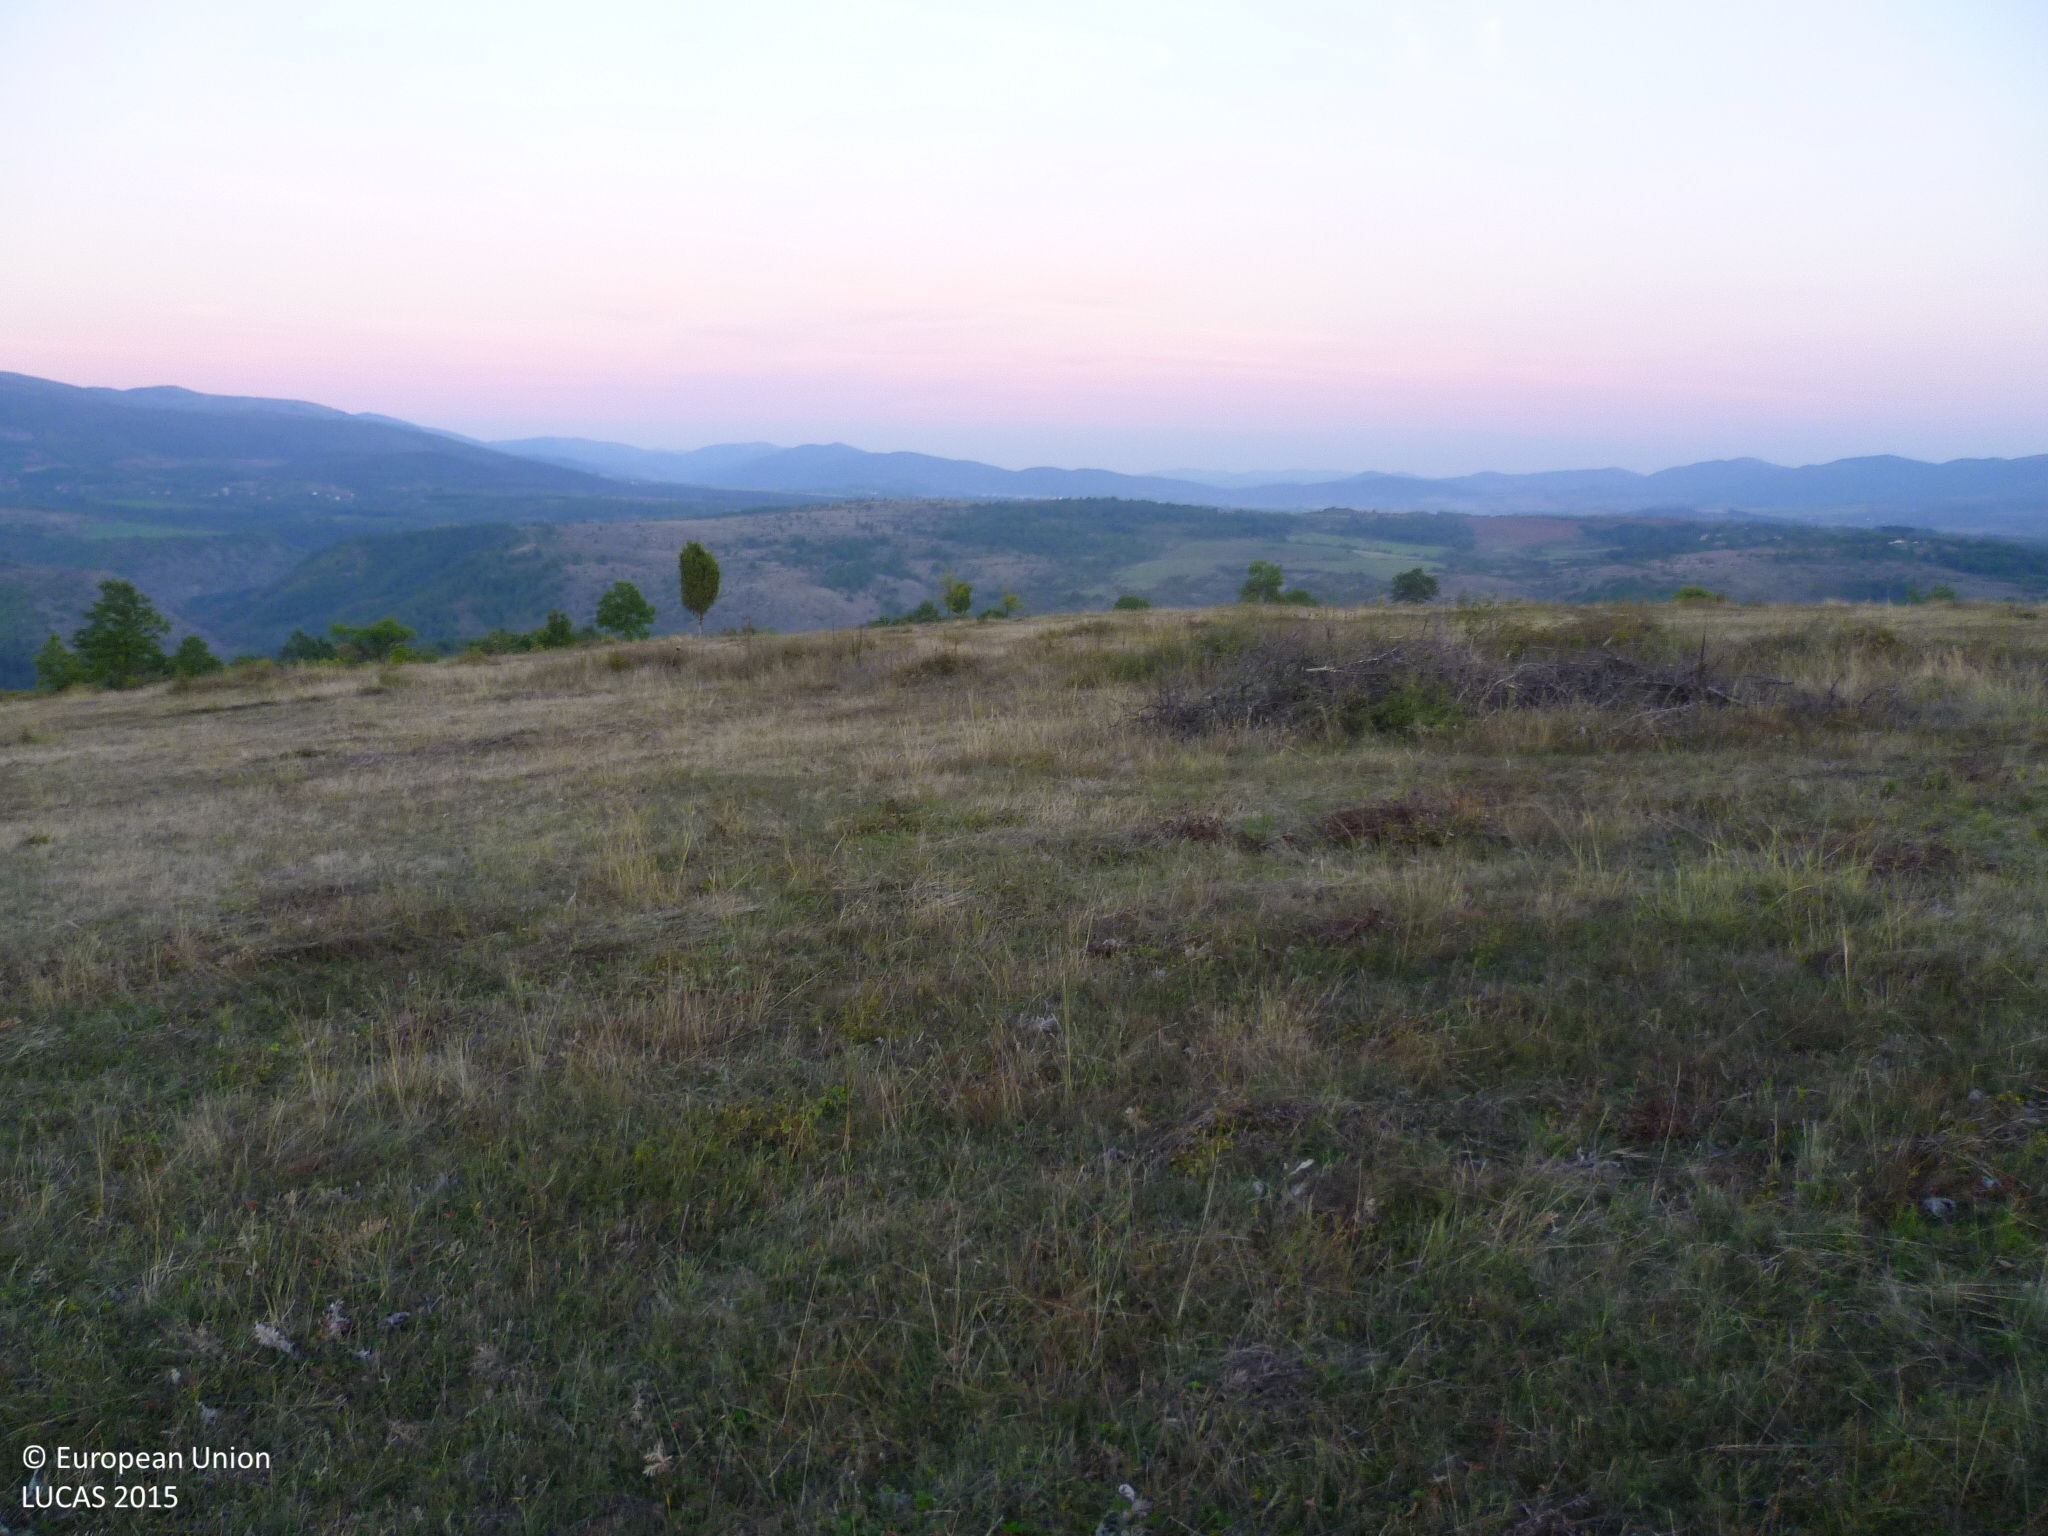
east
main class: Grassland
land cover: Grassland without tree/shrub cover
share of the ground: > 75 %
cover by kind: herbaceous plants 100 %
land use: Agriculture (excluding fallow land and kitchen gardens)
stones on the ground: > 50 %
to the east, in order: Grassland without tree/shrub cover; Abandoned hedges; Grassland with sparse tree/shrub cover; Shrubland with sparse tree cover
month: October
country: BG
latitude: 43.0267
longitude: 22.9298
